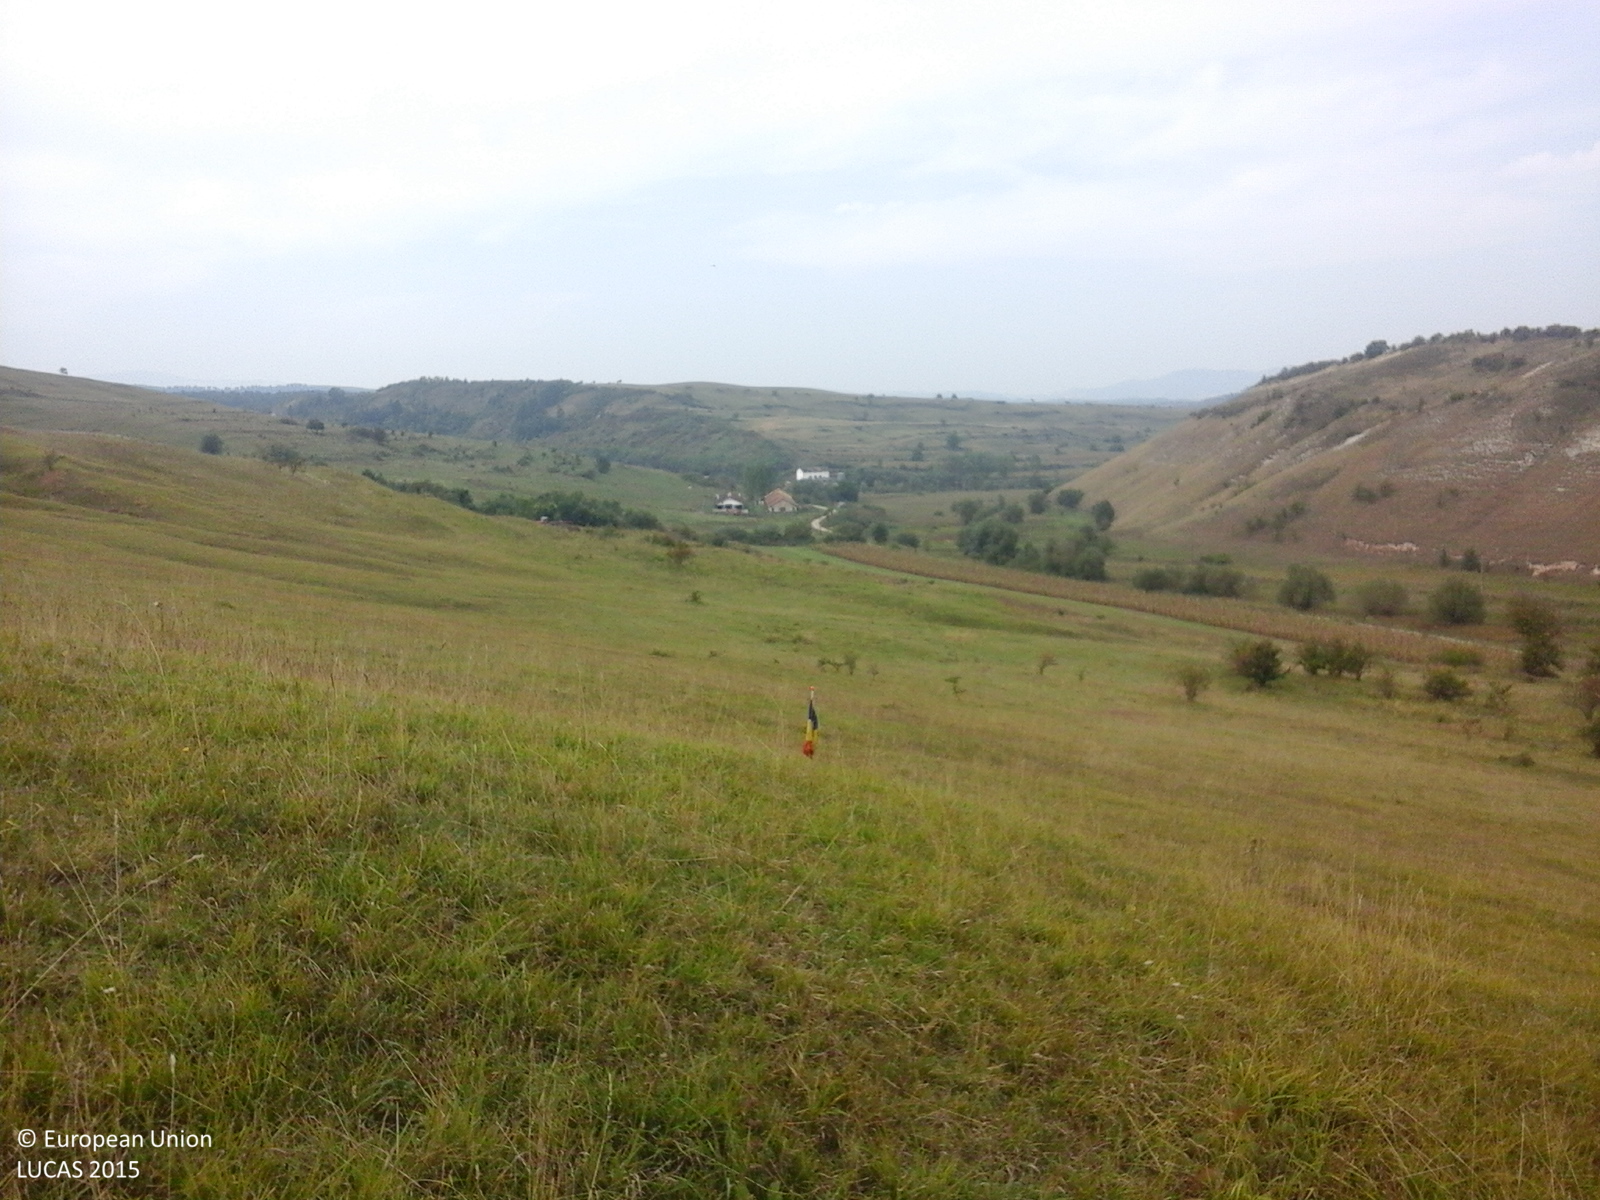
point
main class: Grassland
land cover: Grassland without tree/shrub cover
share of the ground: > 75 %
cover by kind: herbaceous plants 100 %
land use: Agriculture (excluding fallow land and kitchen gardens)
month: September
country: RO
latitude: 46.8882
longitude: 23.1218
